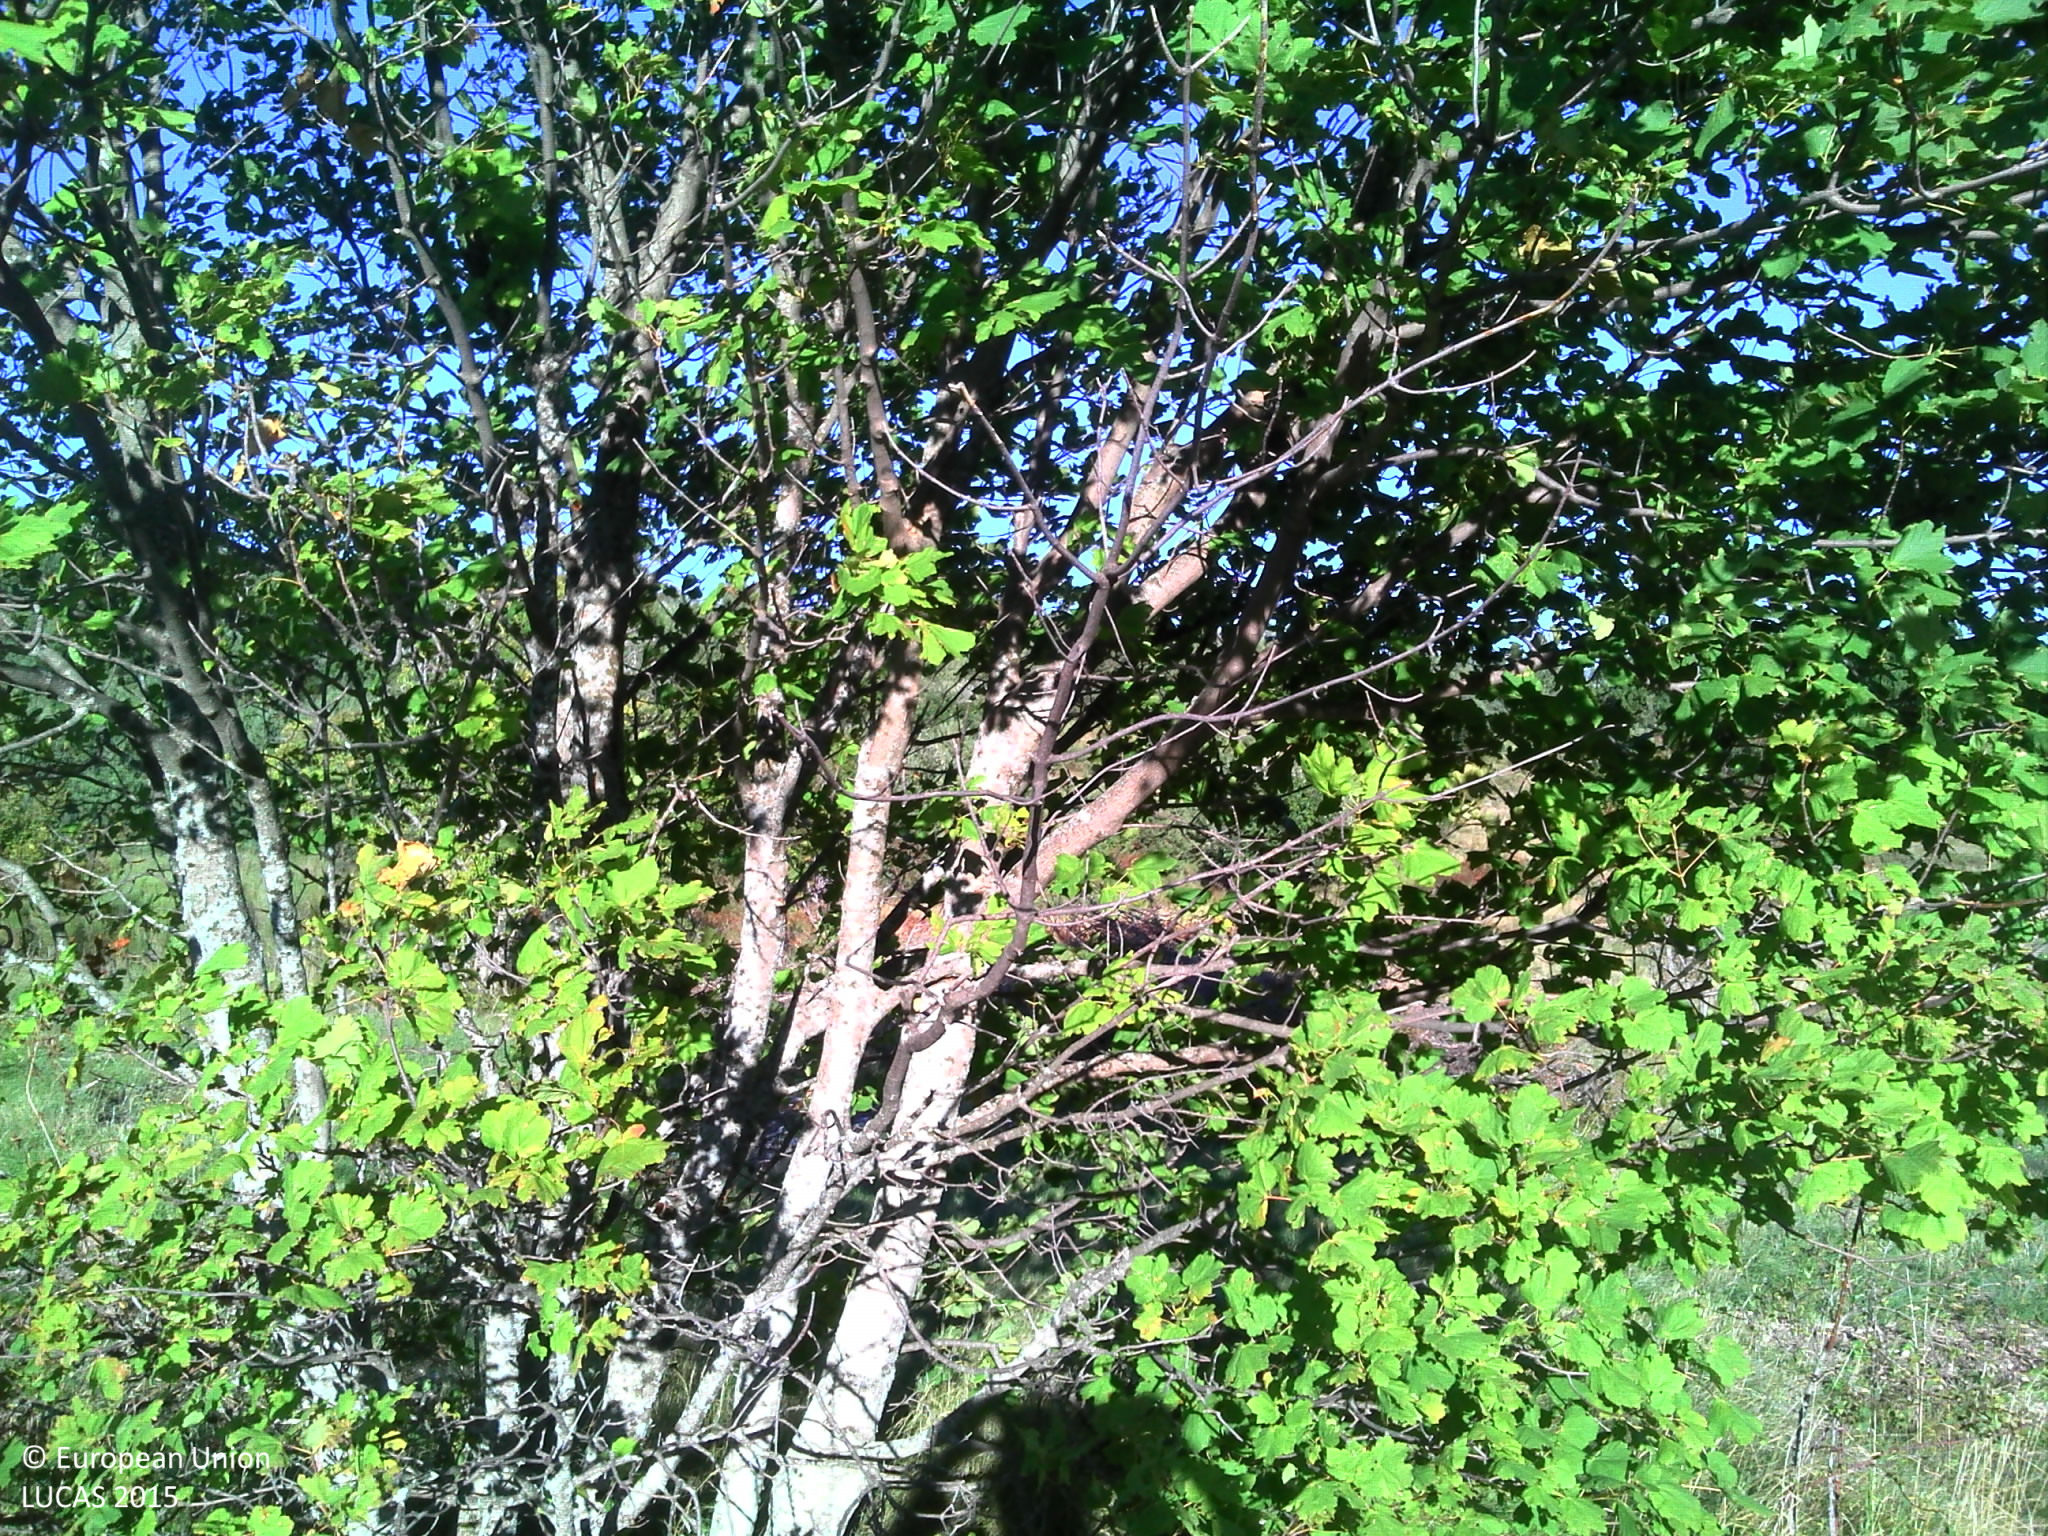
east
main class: Grassland
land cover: Grassland with sparse tree/shrub cover
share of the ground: > 75 %
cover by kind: herbaceous plants 85 %, shrubs 10 %, broadleaved forest trees 5 %
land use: Agriculture (excluding fallow land and kitchen gardens)
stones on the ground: 25 - 50 %
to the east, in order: Grassland with sparse tree/shrub cover; Grassland without tree/shrub cover; Permanent industrial crops; Shrubland without tree cover; Shrubland with sparse tree cover; Pine dominated coniferous woodland; Shrubland with sparse tree cover; Pine dominated coniferous woodland
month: September
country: FR
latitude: 44.1455
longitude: 5.5199
